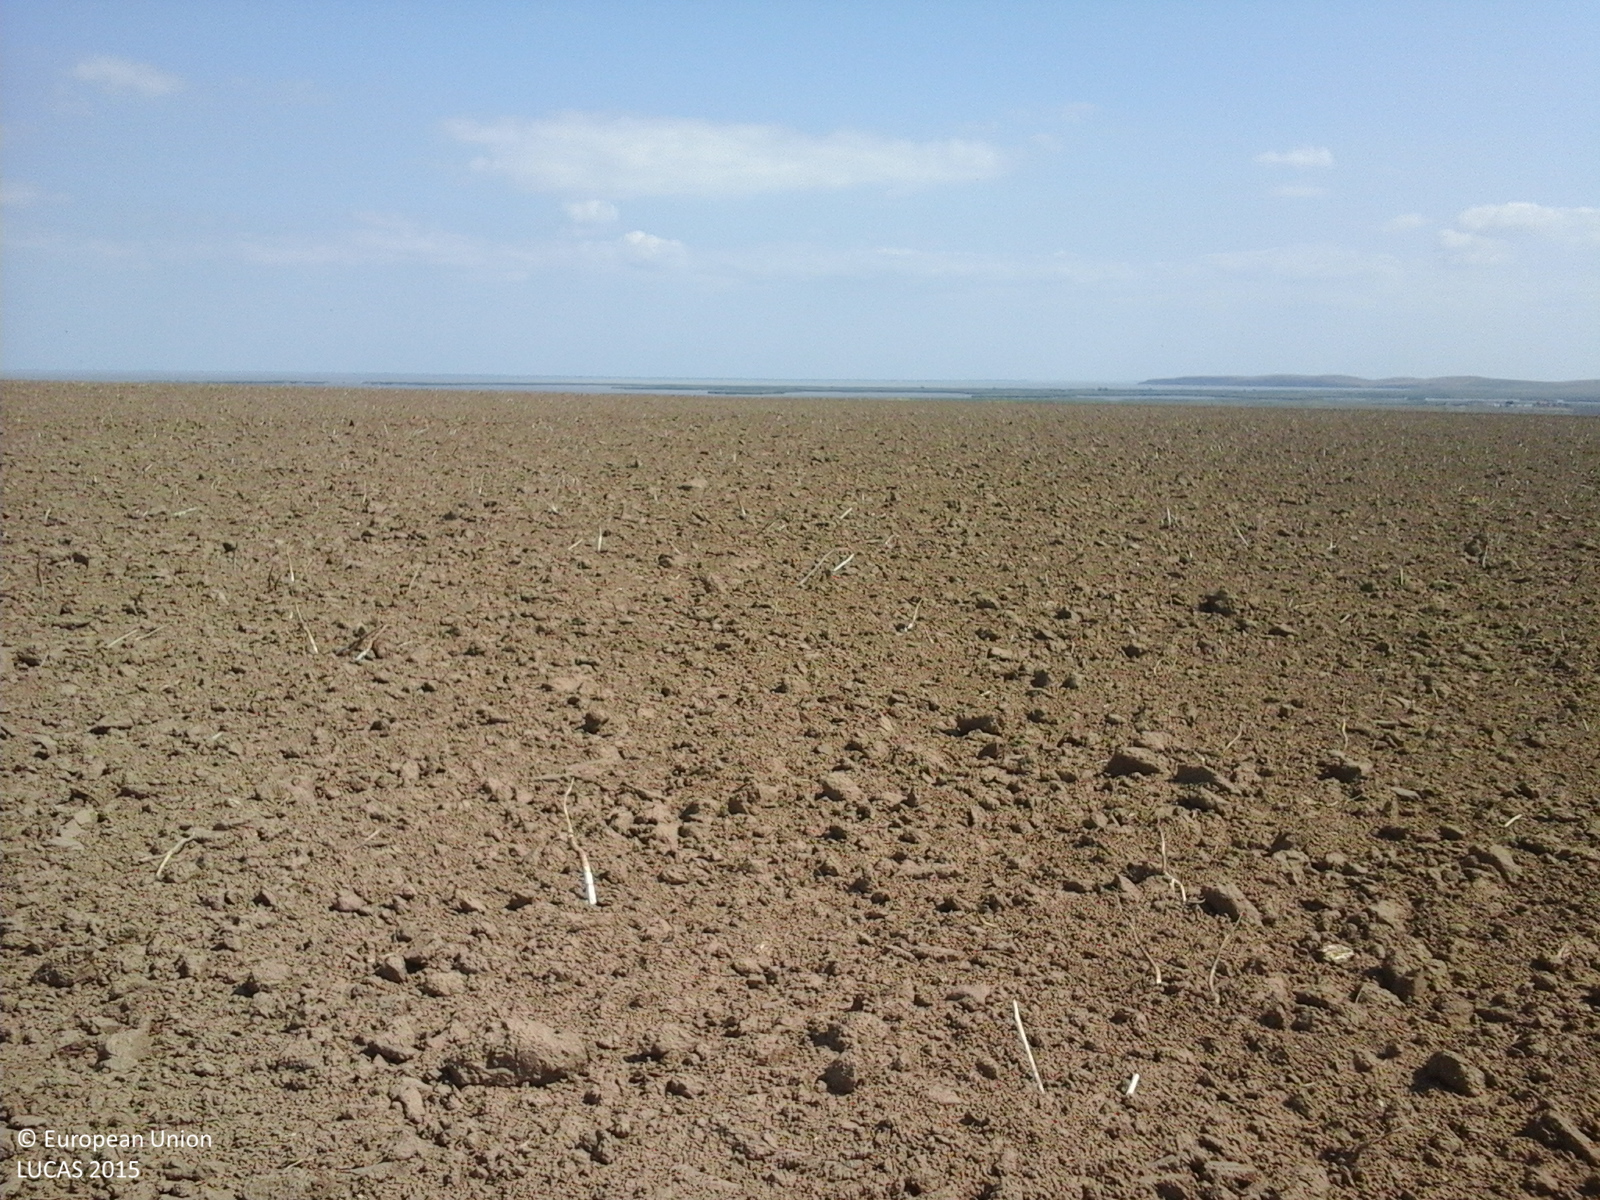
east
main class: Cropland
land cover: Rape and turnip rape
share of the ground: < 10 %
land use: Agriculture (excluding fallow land and kitchen gardens)
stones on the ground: < 10 %
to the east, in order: Rape and turnip rape
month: August
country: RO
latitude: 44.8311
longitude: 28.8986
